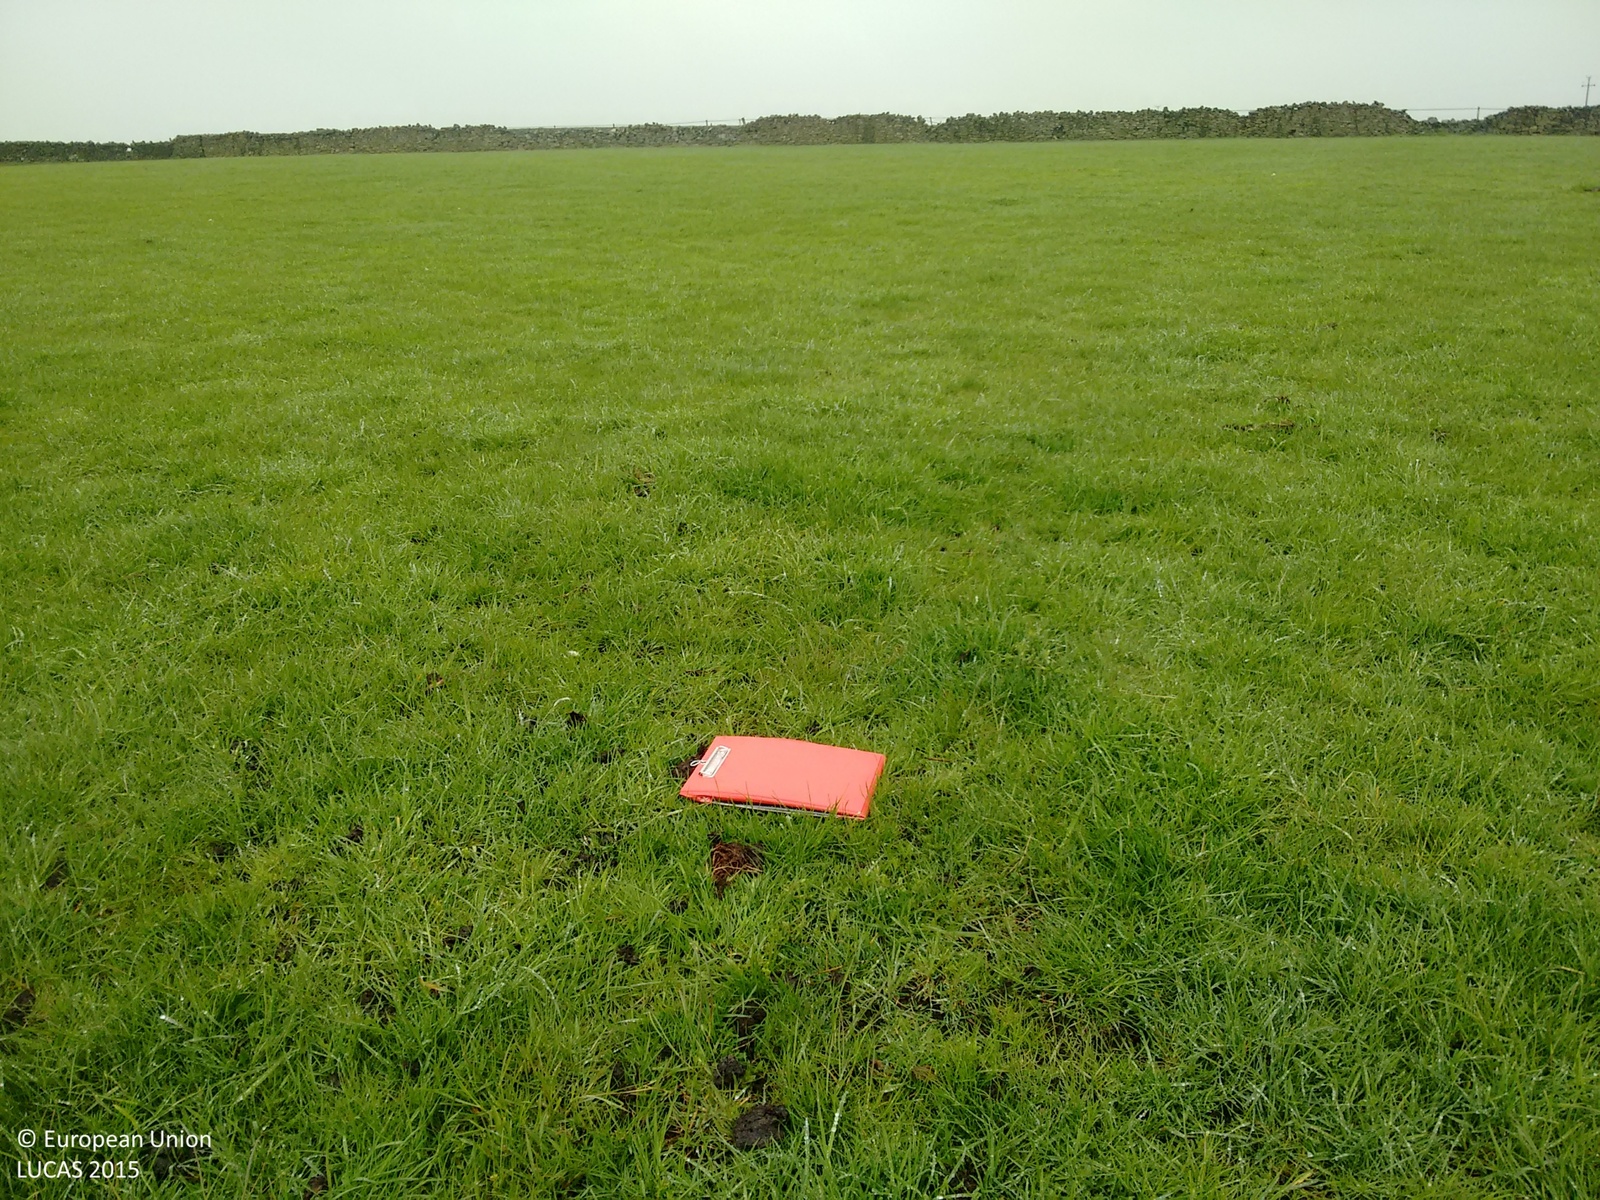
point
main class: Grassland
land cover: Grassland without tree/shrub cover
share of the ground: > 75 %
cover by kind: herbaceous plants 100 %
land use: Agriculture (excluding fallow land and kitchen gardens)
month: May
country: GB
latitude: 53.8288
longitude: -1.9218
